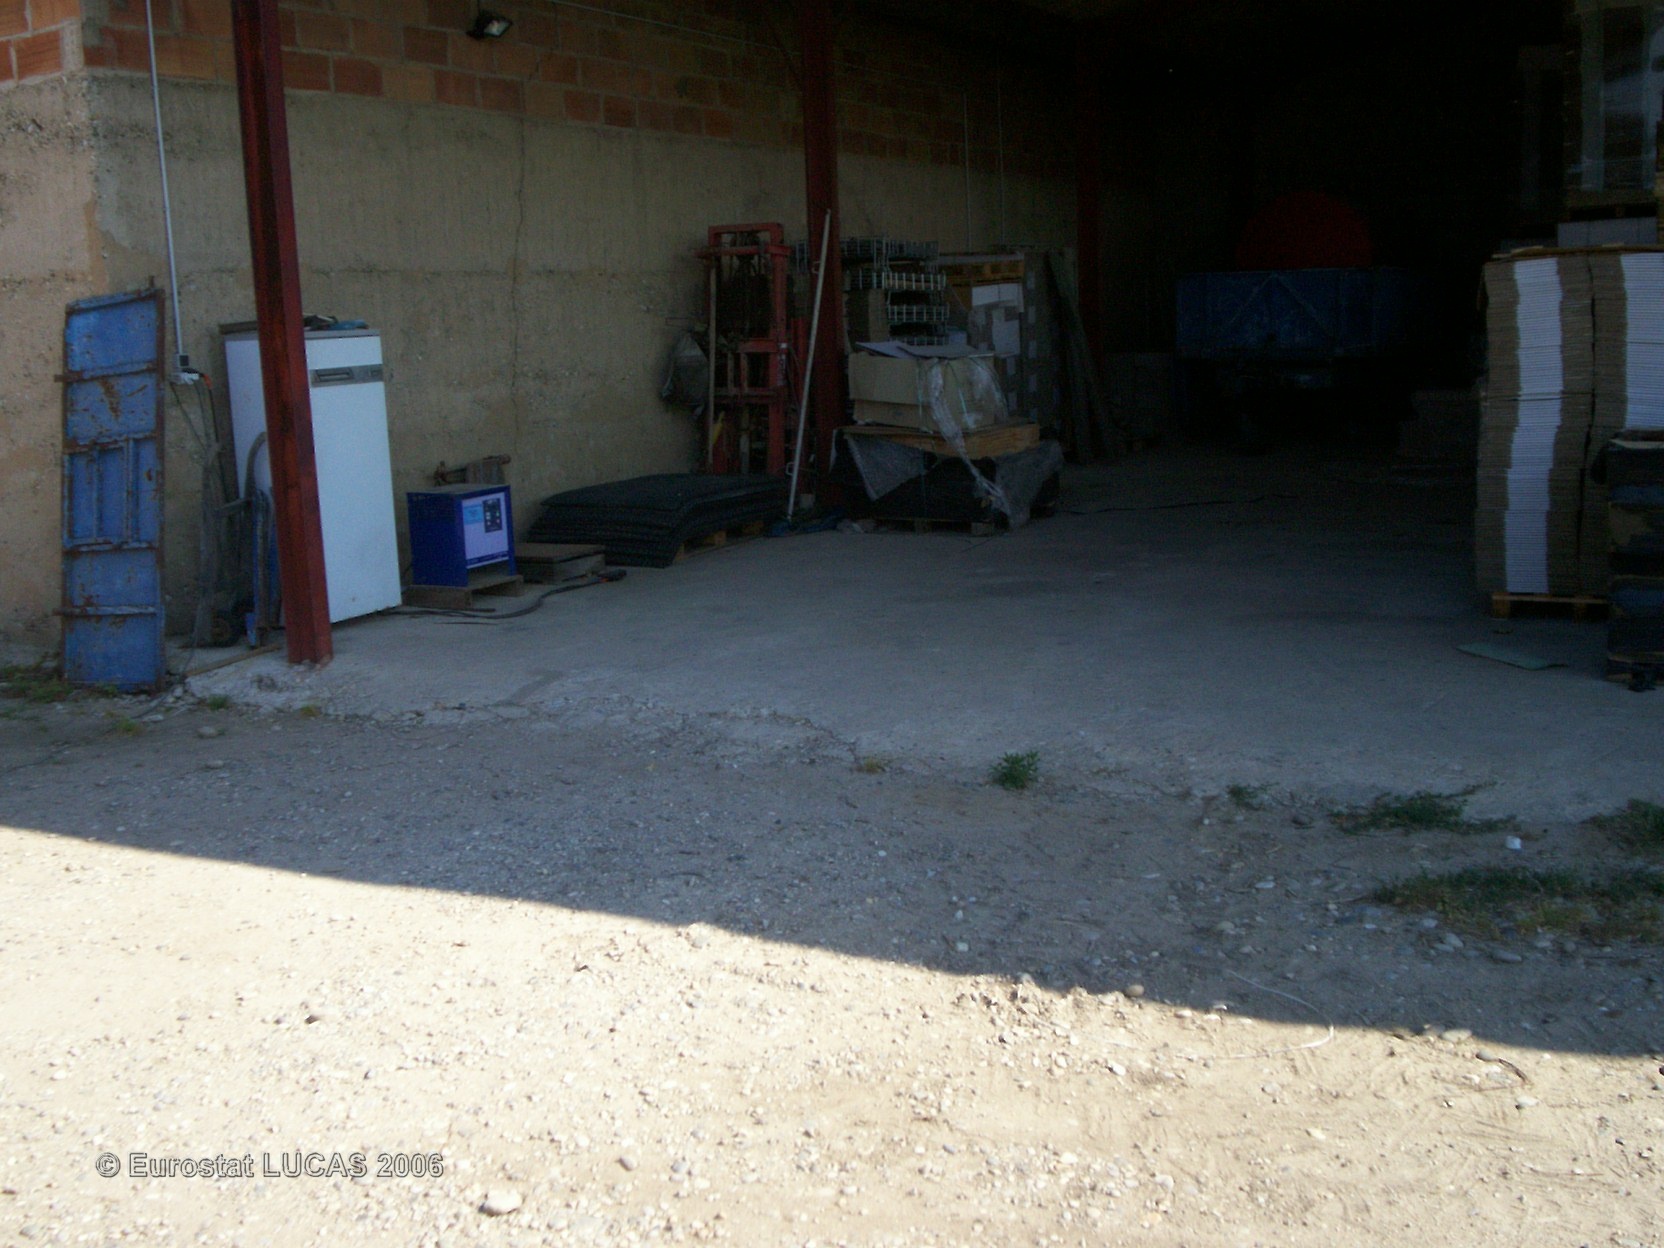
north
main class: Cropland
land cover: Other fruit trees and berries
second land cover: Grassland with sparse tree/shrub cover
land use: Agriculture (excluding fallow land and kitchen gardens)
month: June
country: FR
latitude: 45.0723
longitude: 4.8611
